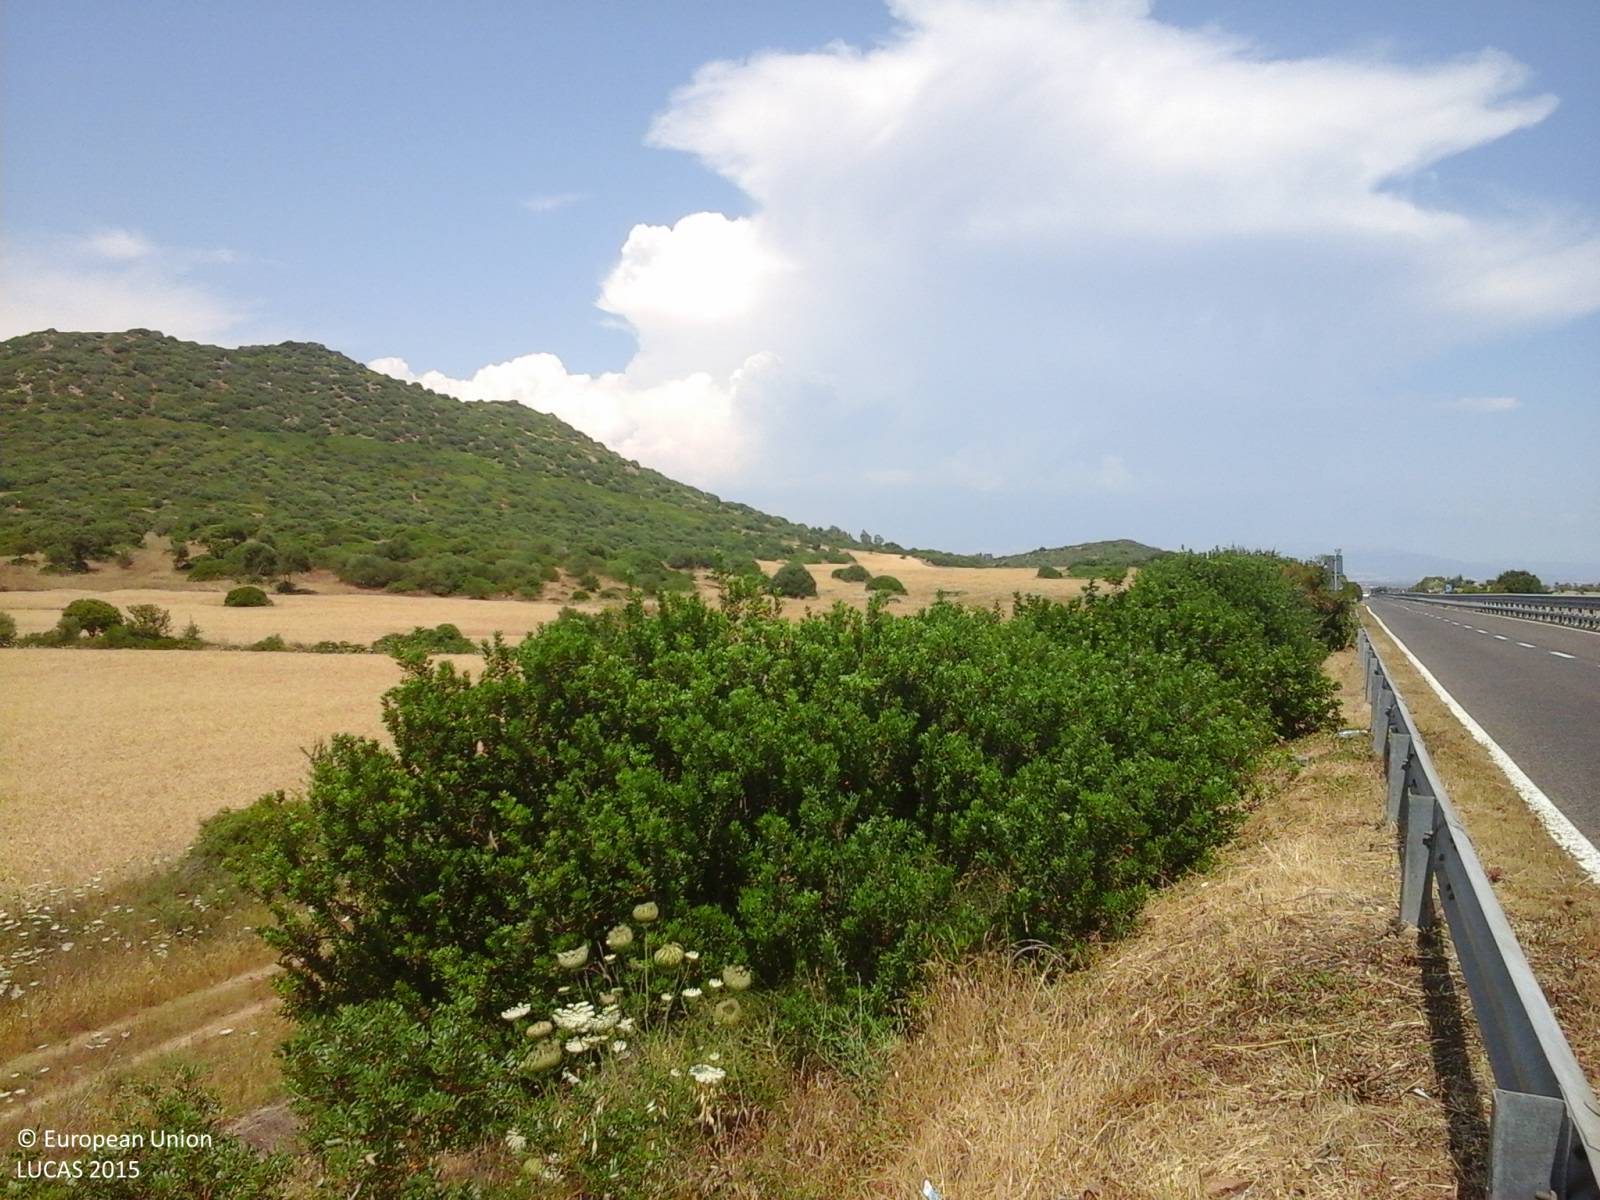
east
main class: Shrubland
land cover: Shrubland without tree cover
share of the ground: > 75 %
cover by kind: herbaceous plants 60 %, shrubs 40 %
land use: Road transport
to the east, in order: Shrubland without tree cover; Paved roads, cycling and walking lanes; Shrubland without tree cover; Ditches and canals; Shrubland without tree cover; Abandoned hedges; Tracks; Grassland without tree/shrub cover
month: June
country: IT
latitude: 39.3007
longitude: 8.8590
